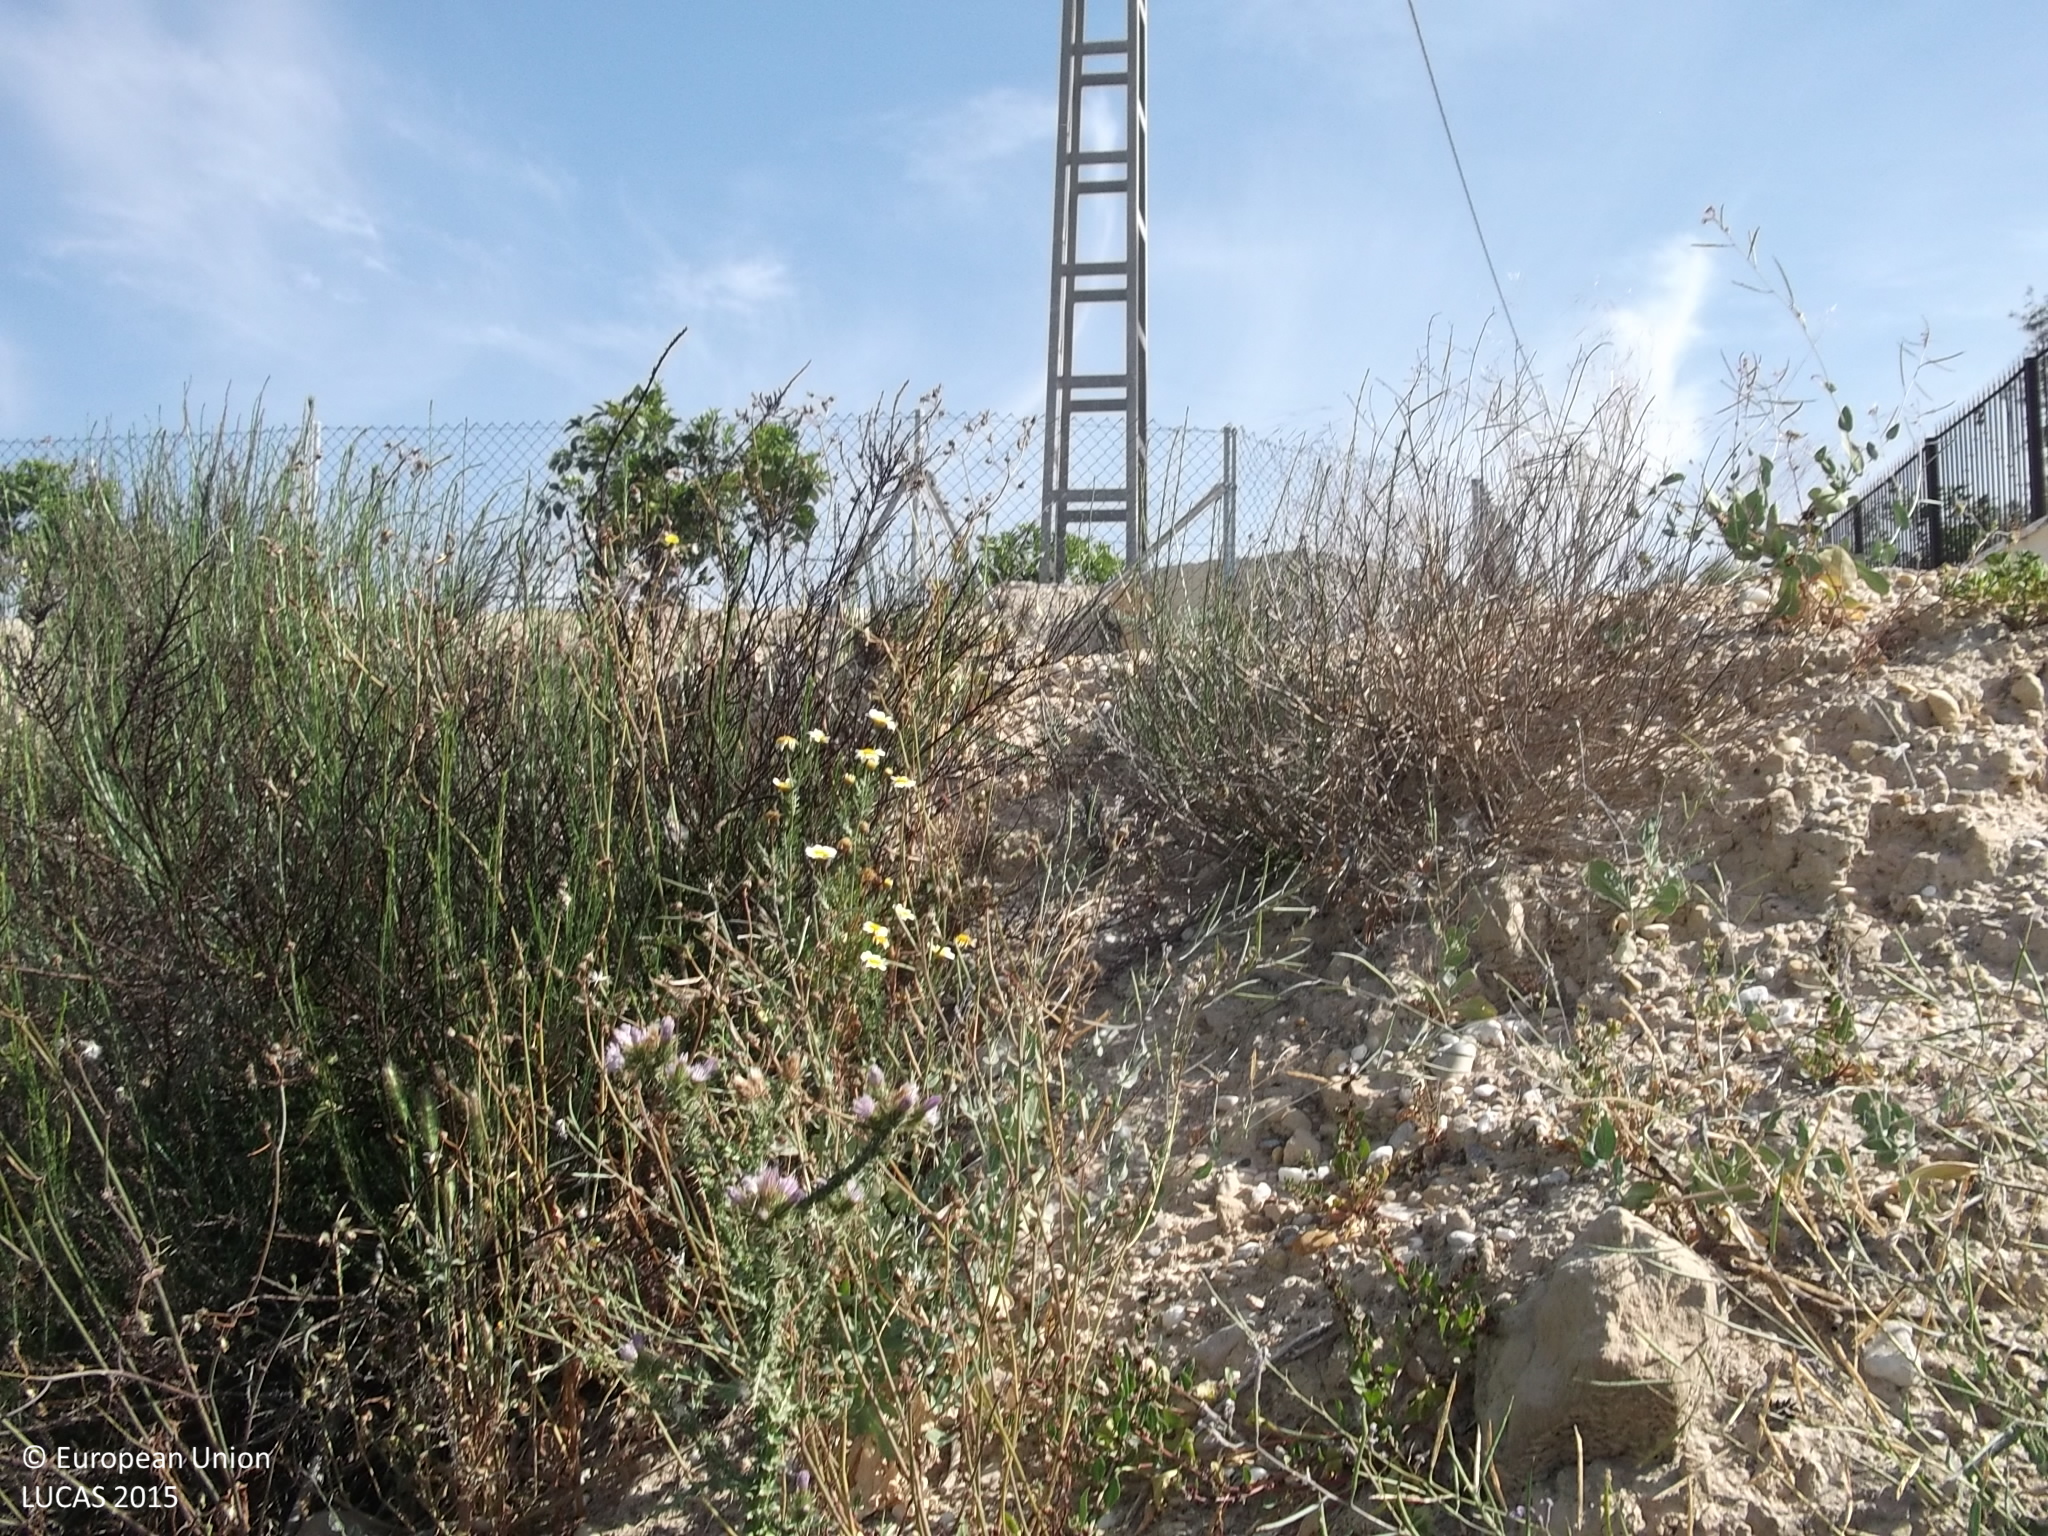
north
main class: Cropland
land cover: Other citrus fruit
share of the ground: 50 - 75 %
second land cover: Spontaneously vegetated surfaces
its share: > 75 %
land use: Agriculture (excluding fallow land and kitchen gardens)
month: April
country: ES
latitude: 38.0448
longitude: -0.9571
